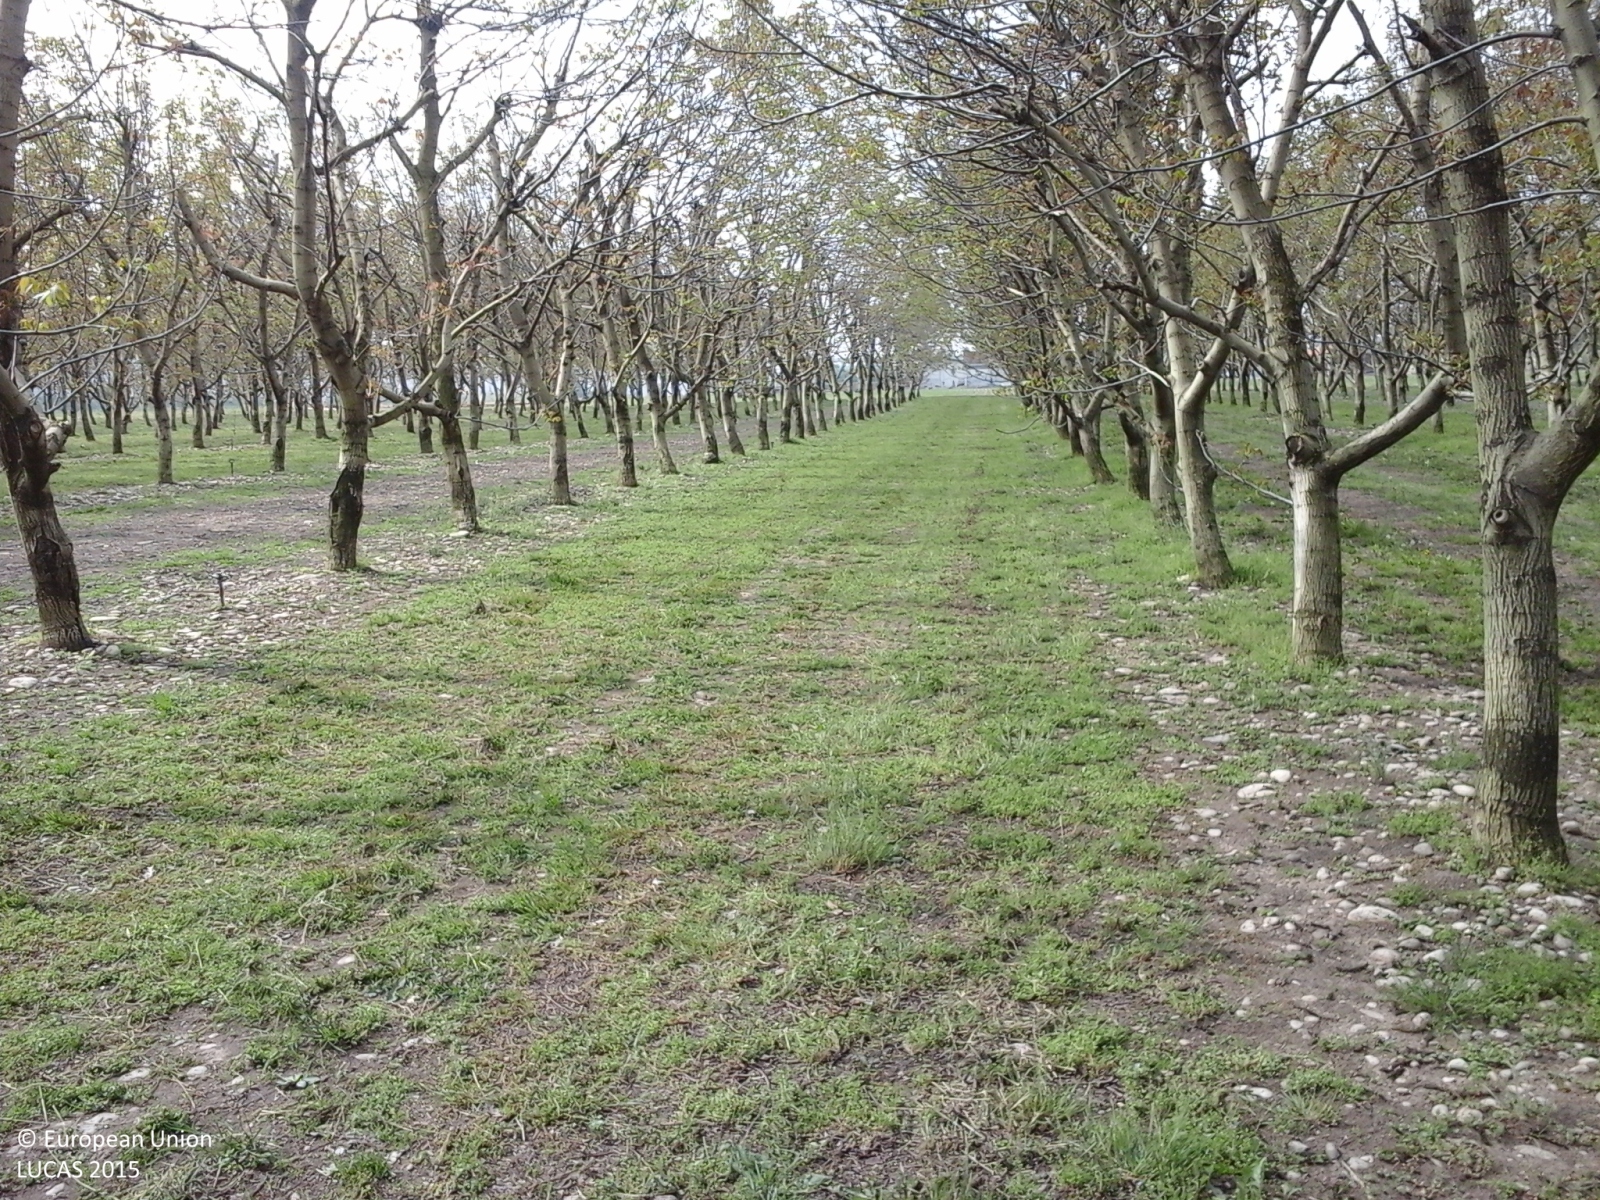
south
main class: Cropland
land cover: Nuts trees
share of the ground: 50 - 75 %
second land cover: Grassland without tree/shrub cover
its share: 50 - 75 %
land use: Agriculture (excluding fallow land and kitchen gardens)
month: May
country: IT
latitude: 44.5973
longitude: 7.7747
